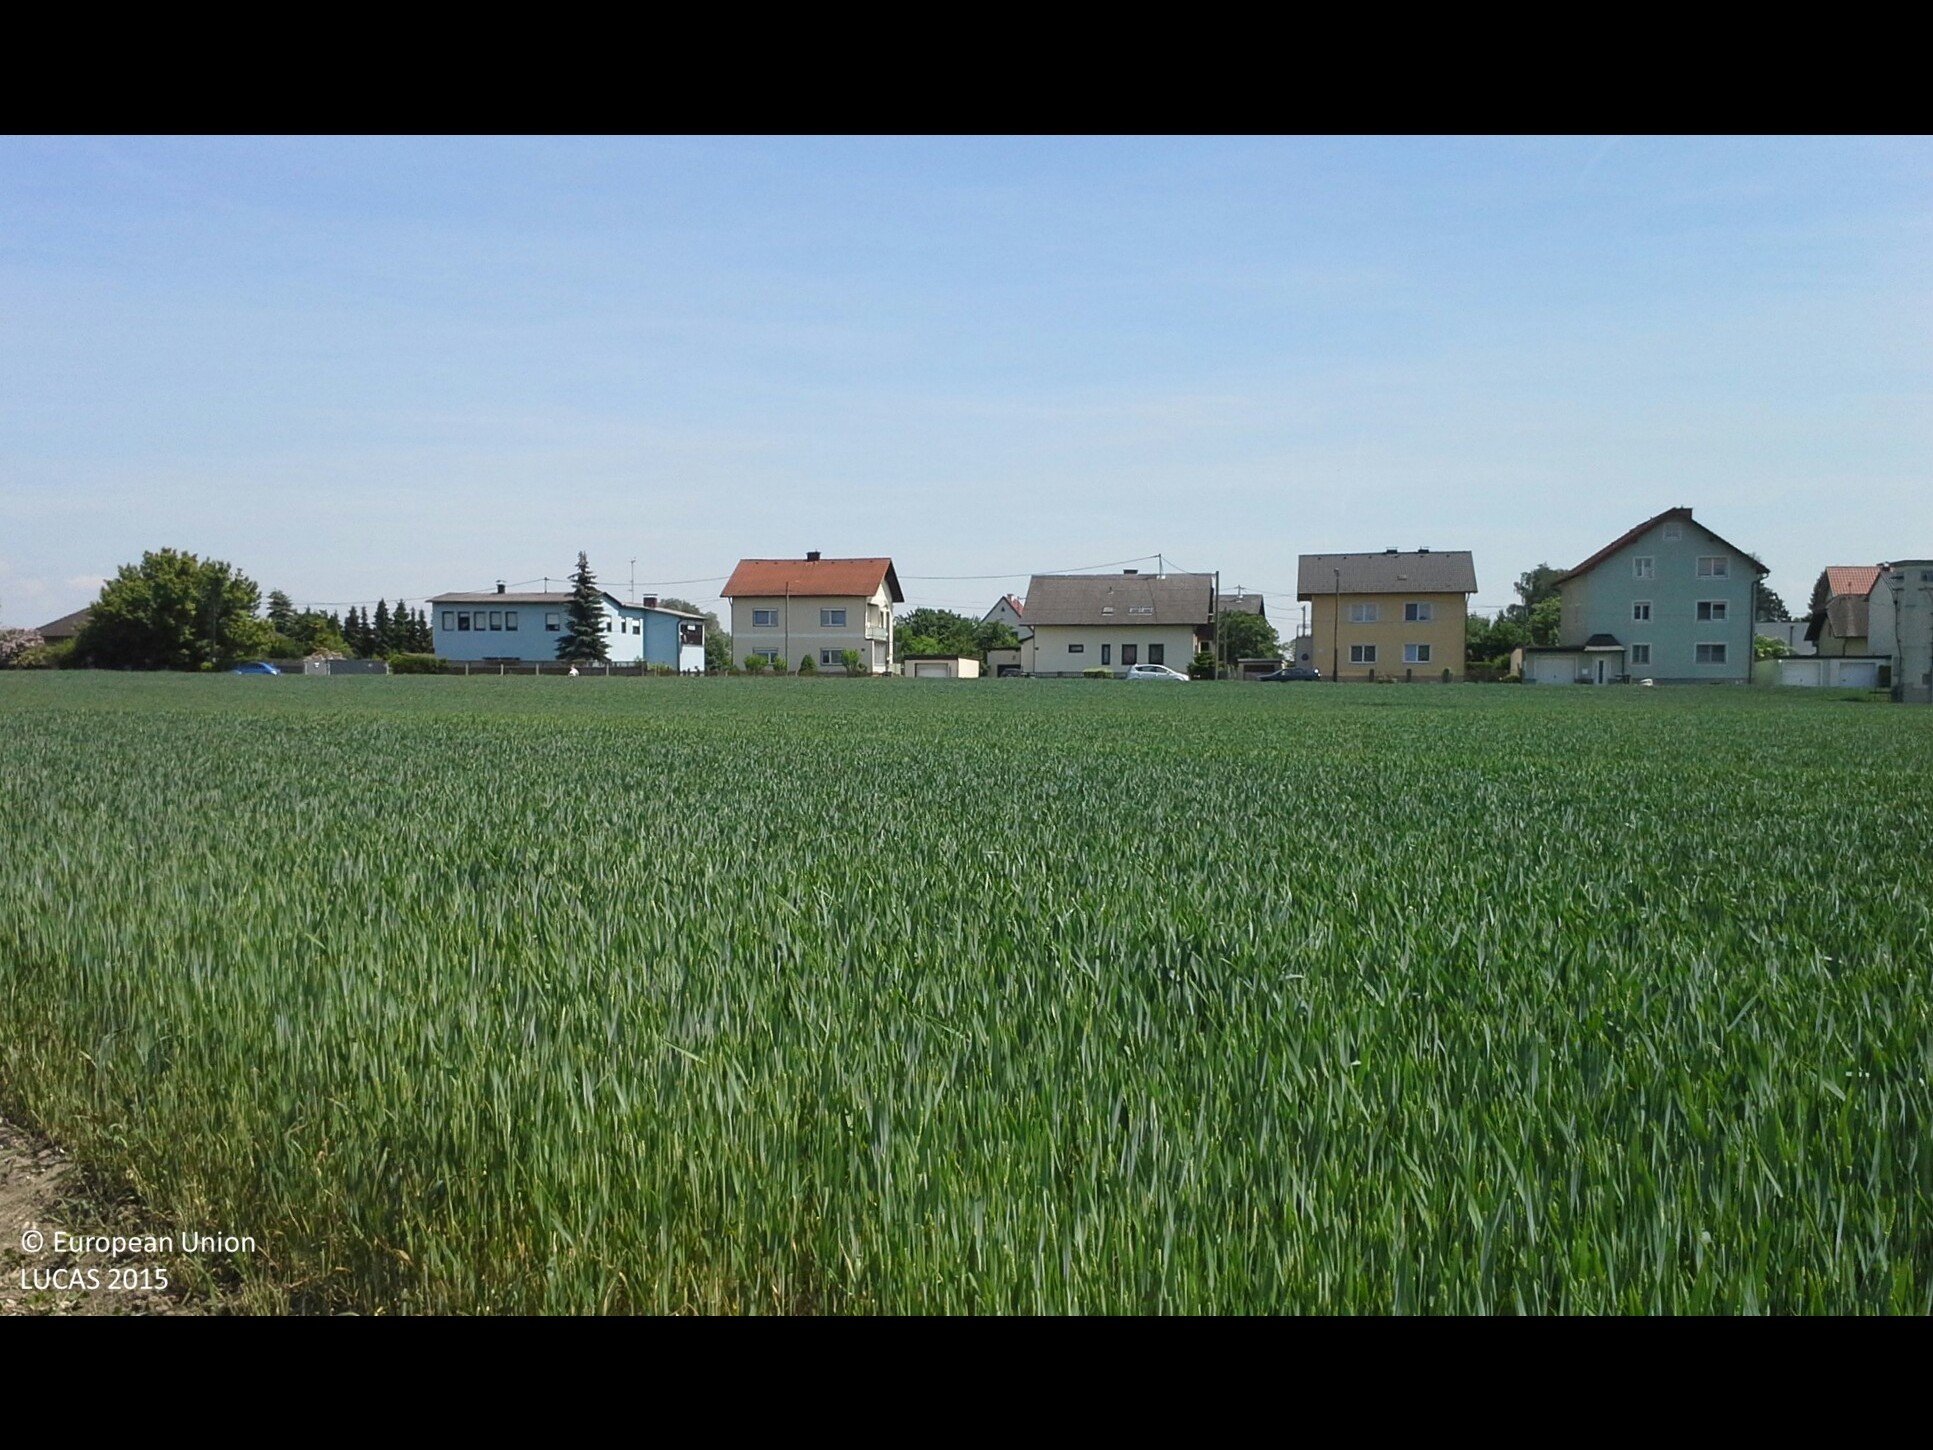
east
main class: Cropland
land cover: Soya
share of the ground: 10 - 25 %
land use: Agriculture (excluding fallow land and kitchen gardens)
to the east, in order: Soya; Grass margins; Common wheat; Grass margins; Artificial constructions in urban areas; Grass margins; Common wheat
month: May
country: AT
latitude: 48.2448
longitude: 14.3767
